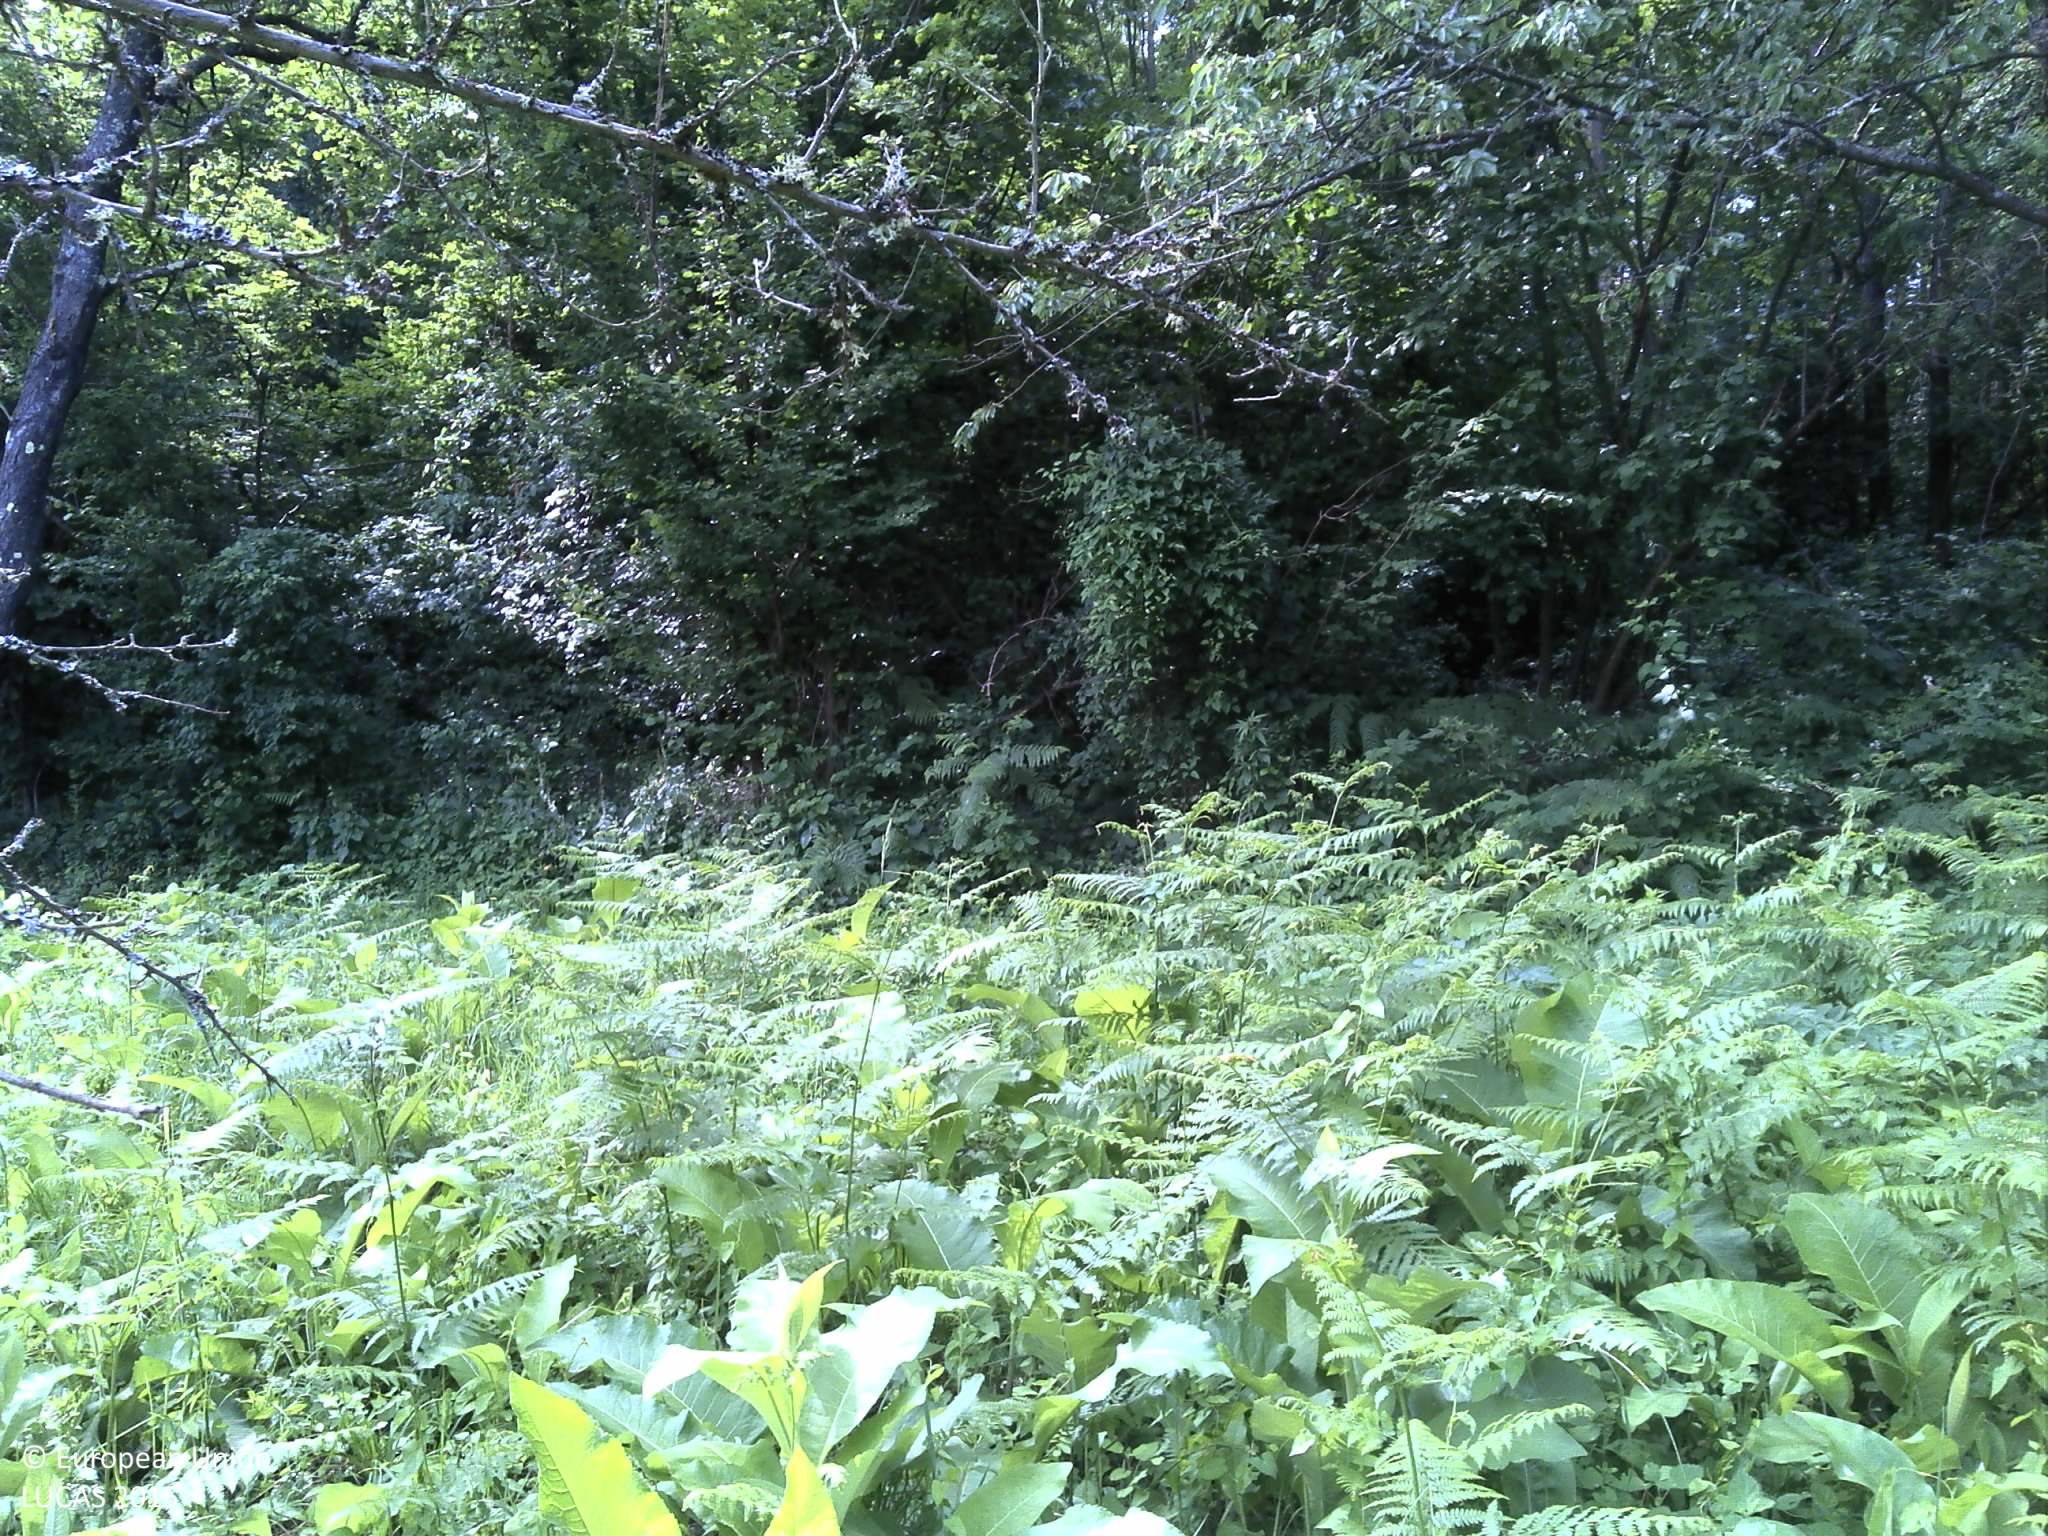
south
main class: Cropland
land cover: Other fruit trees and berries
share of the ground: > 75 %
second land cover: Grassland without tree/shrub cover
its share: > 75 %
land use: Agriculture (excluding fallow land and kitchen gardens)
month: June
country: HR
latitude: 45.3195
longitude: 17.6172
